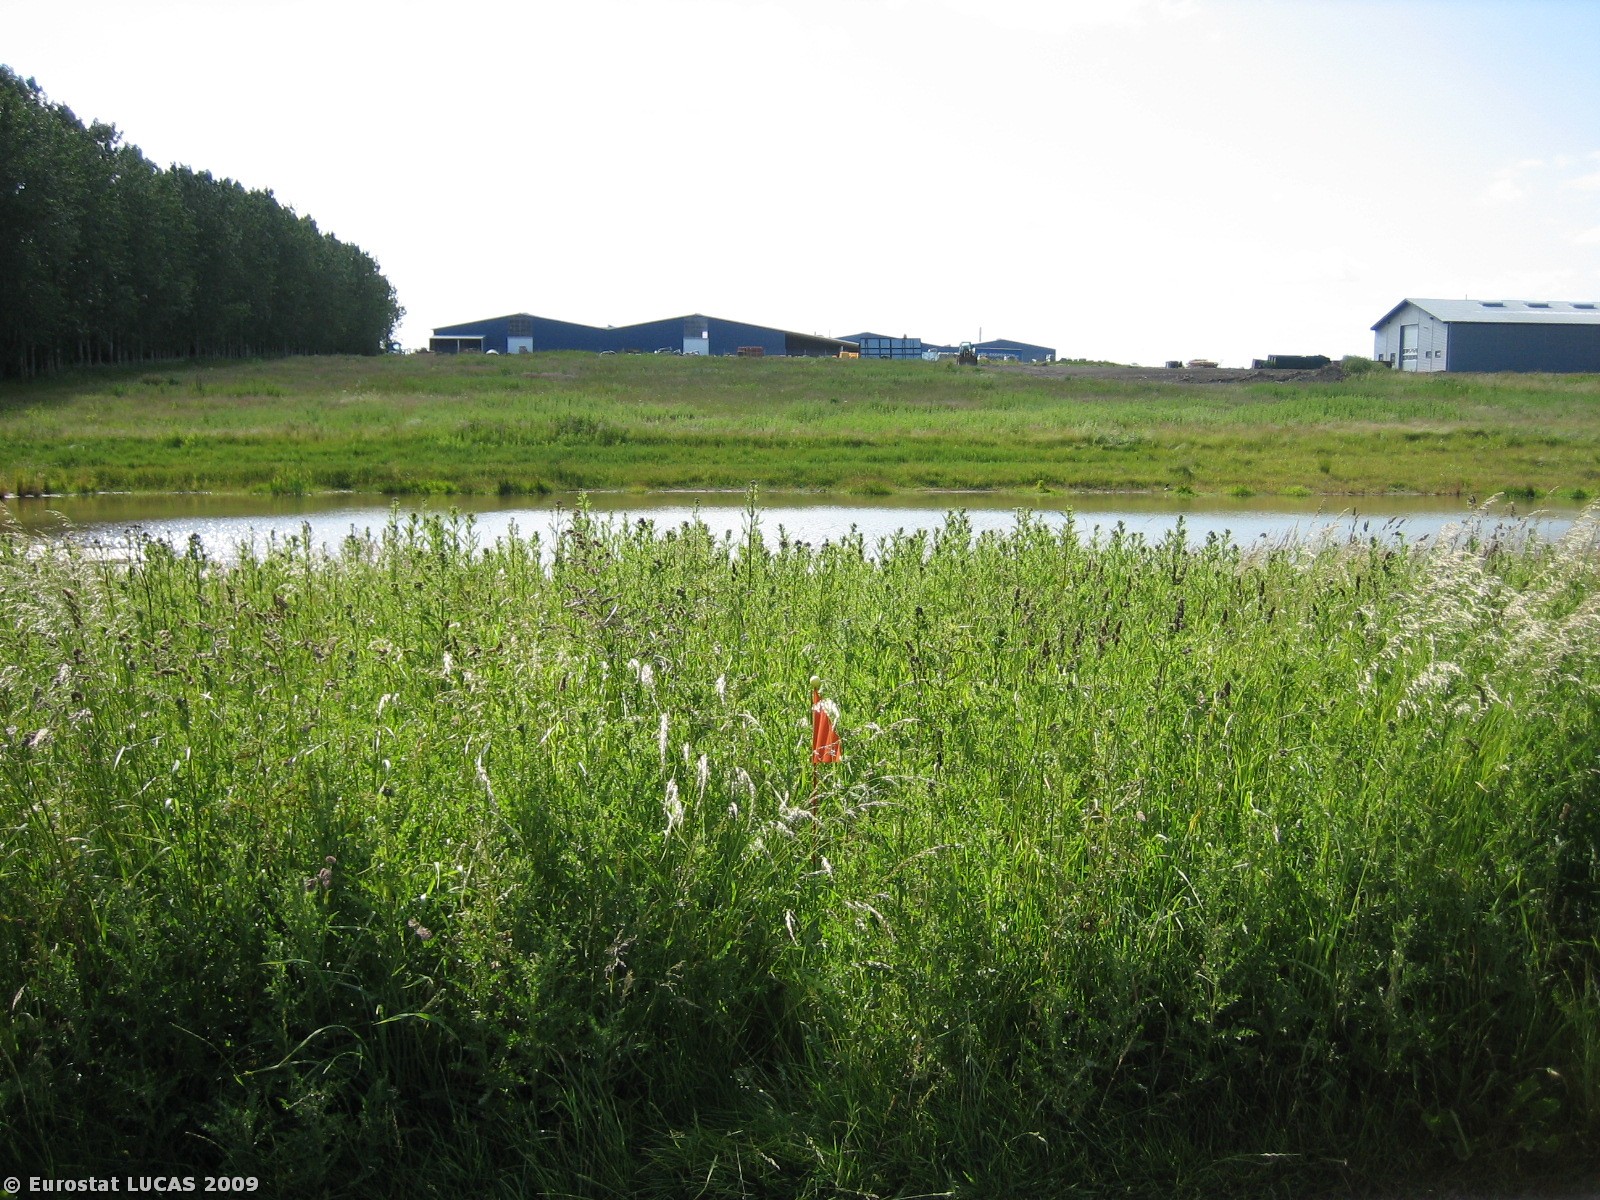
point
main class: Grassland
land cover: Grassland without tree/shrub cover
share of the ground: > 75 %
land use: Unused
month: June
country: DK
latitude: 55.7560
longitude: 9.6976
